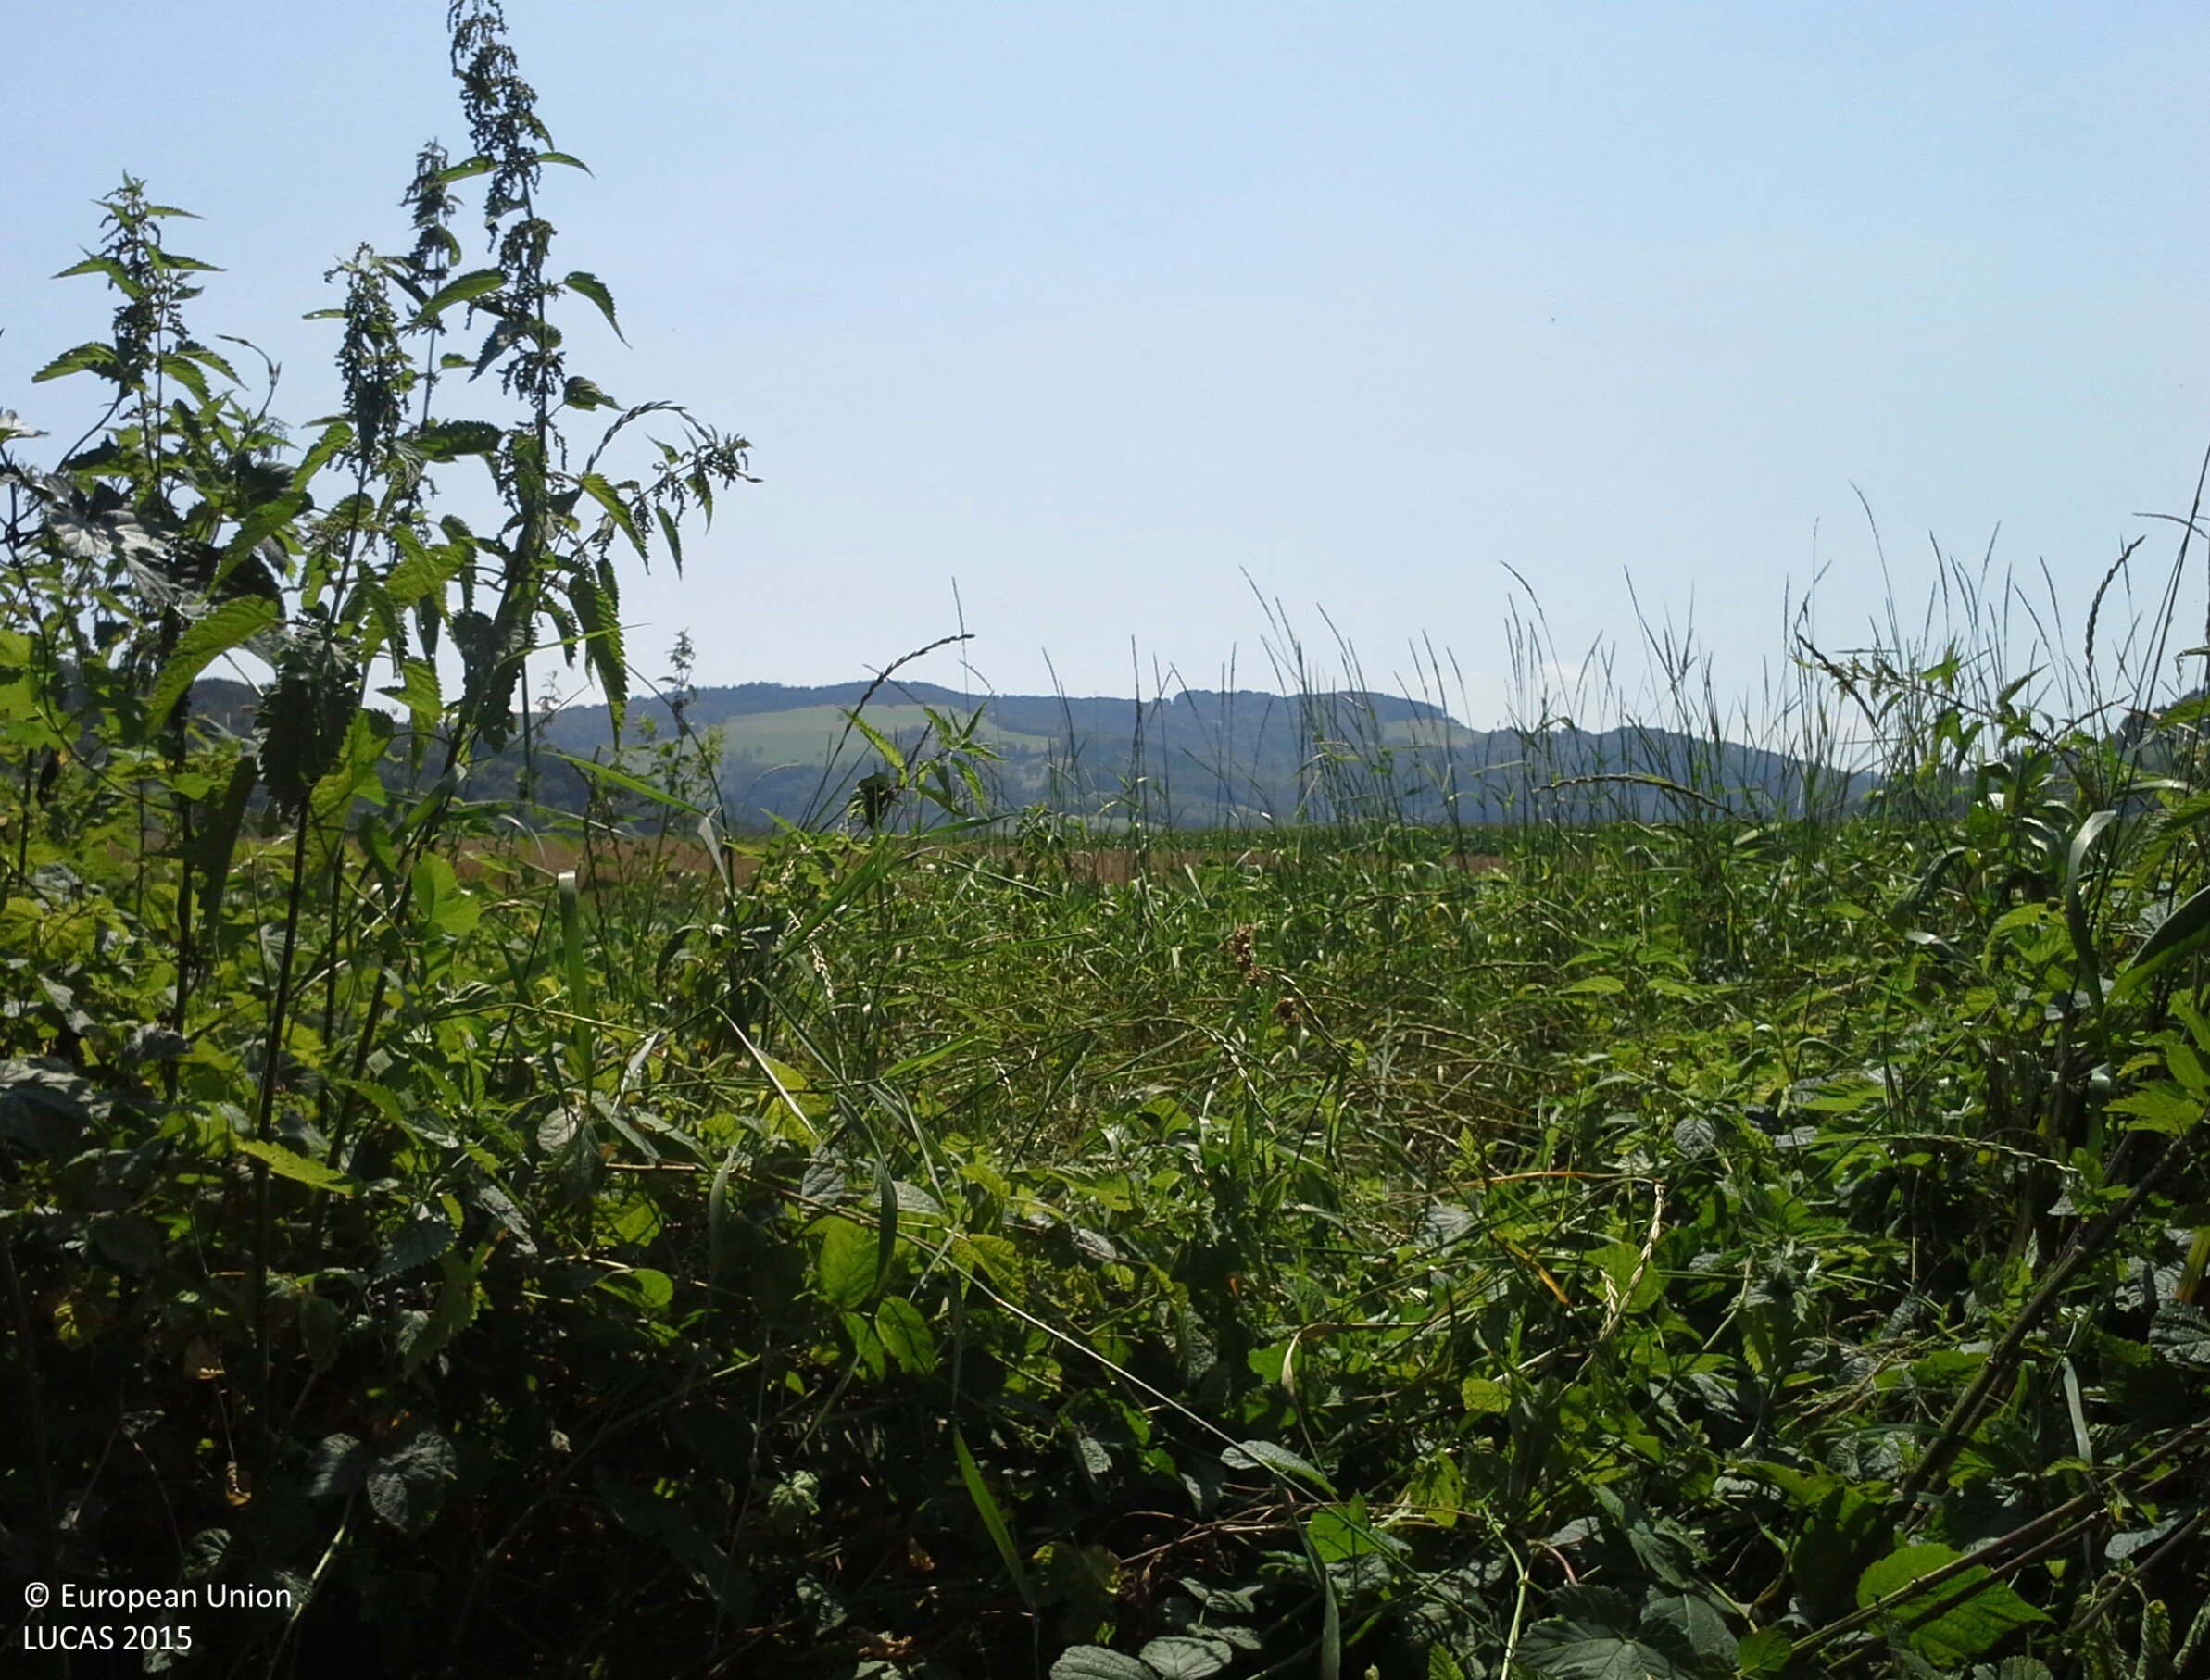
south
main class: Woodland
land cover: Broadleaved woodland
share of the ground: 50 - 75 %
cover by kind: broadleaved forest trees 60 %, shrubs 20 %, herbaceous plants 20 %
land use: Semi-natural and natural areas not in use
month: July
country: AT
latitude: 48.0546
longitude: 15.0323
